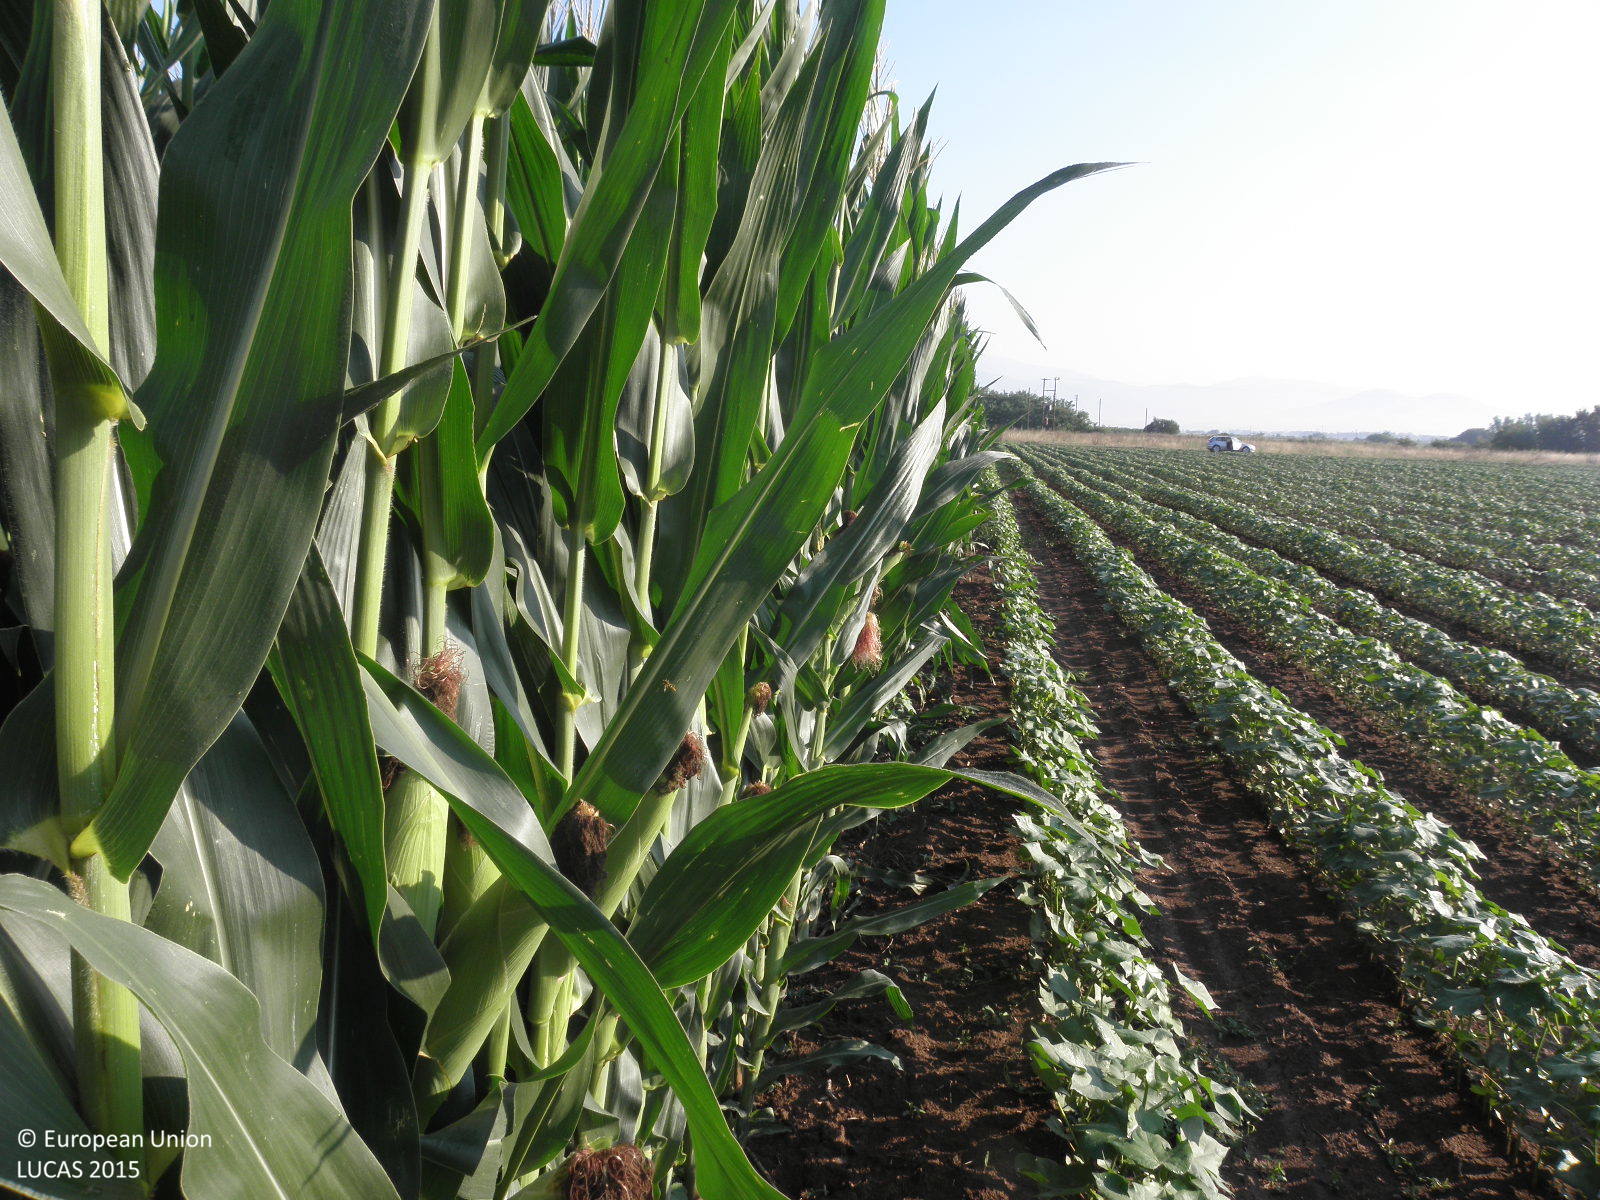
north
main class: Cropland
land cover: Maize
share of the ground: > 75 %
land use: Agriculture (excluding fallow land and kitchen gardens)
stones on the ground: < 10 %
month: July
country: GR
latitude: 39.6777
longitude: 22.4066
